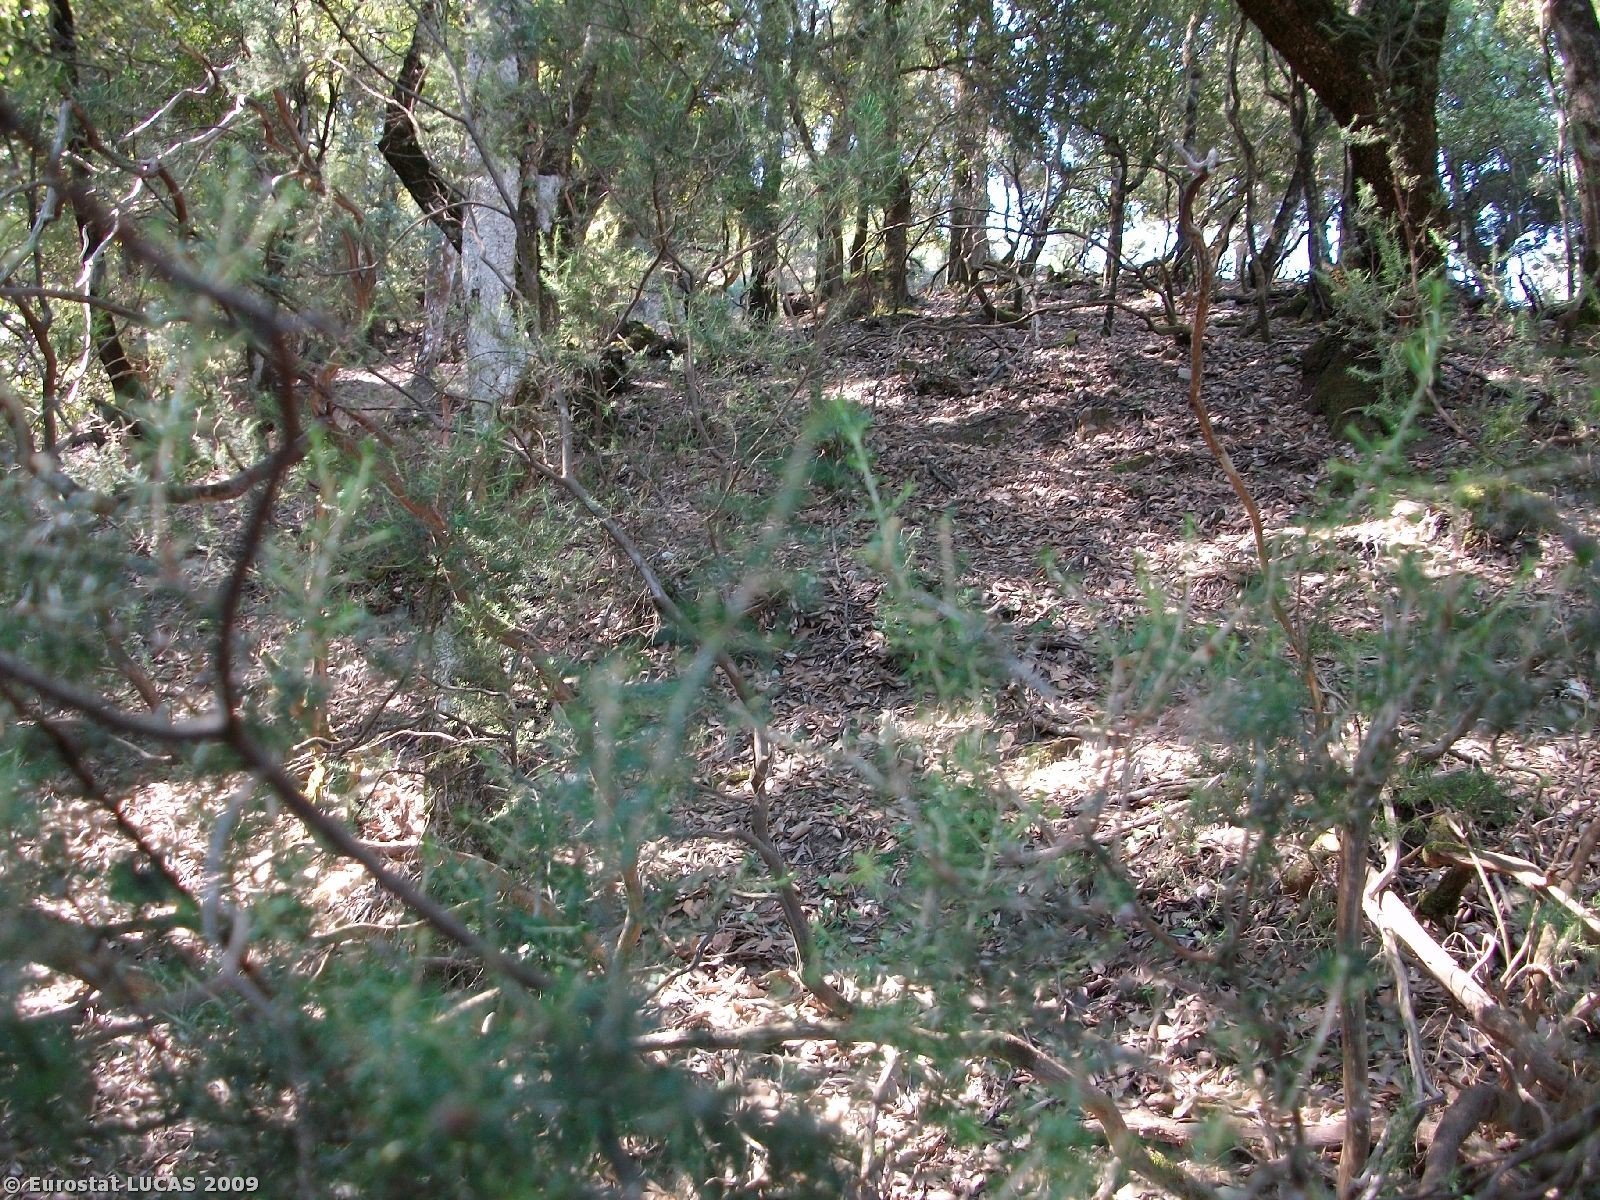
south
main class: Woodland
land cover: Broadleaved woodland
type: acidophilous oak and oak-birch forest
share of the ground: > 75 %
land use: Forestry
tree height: > 5 m
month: August
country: GR
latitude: 38.9644
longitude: 21.5272
